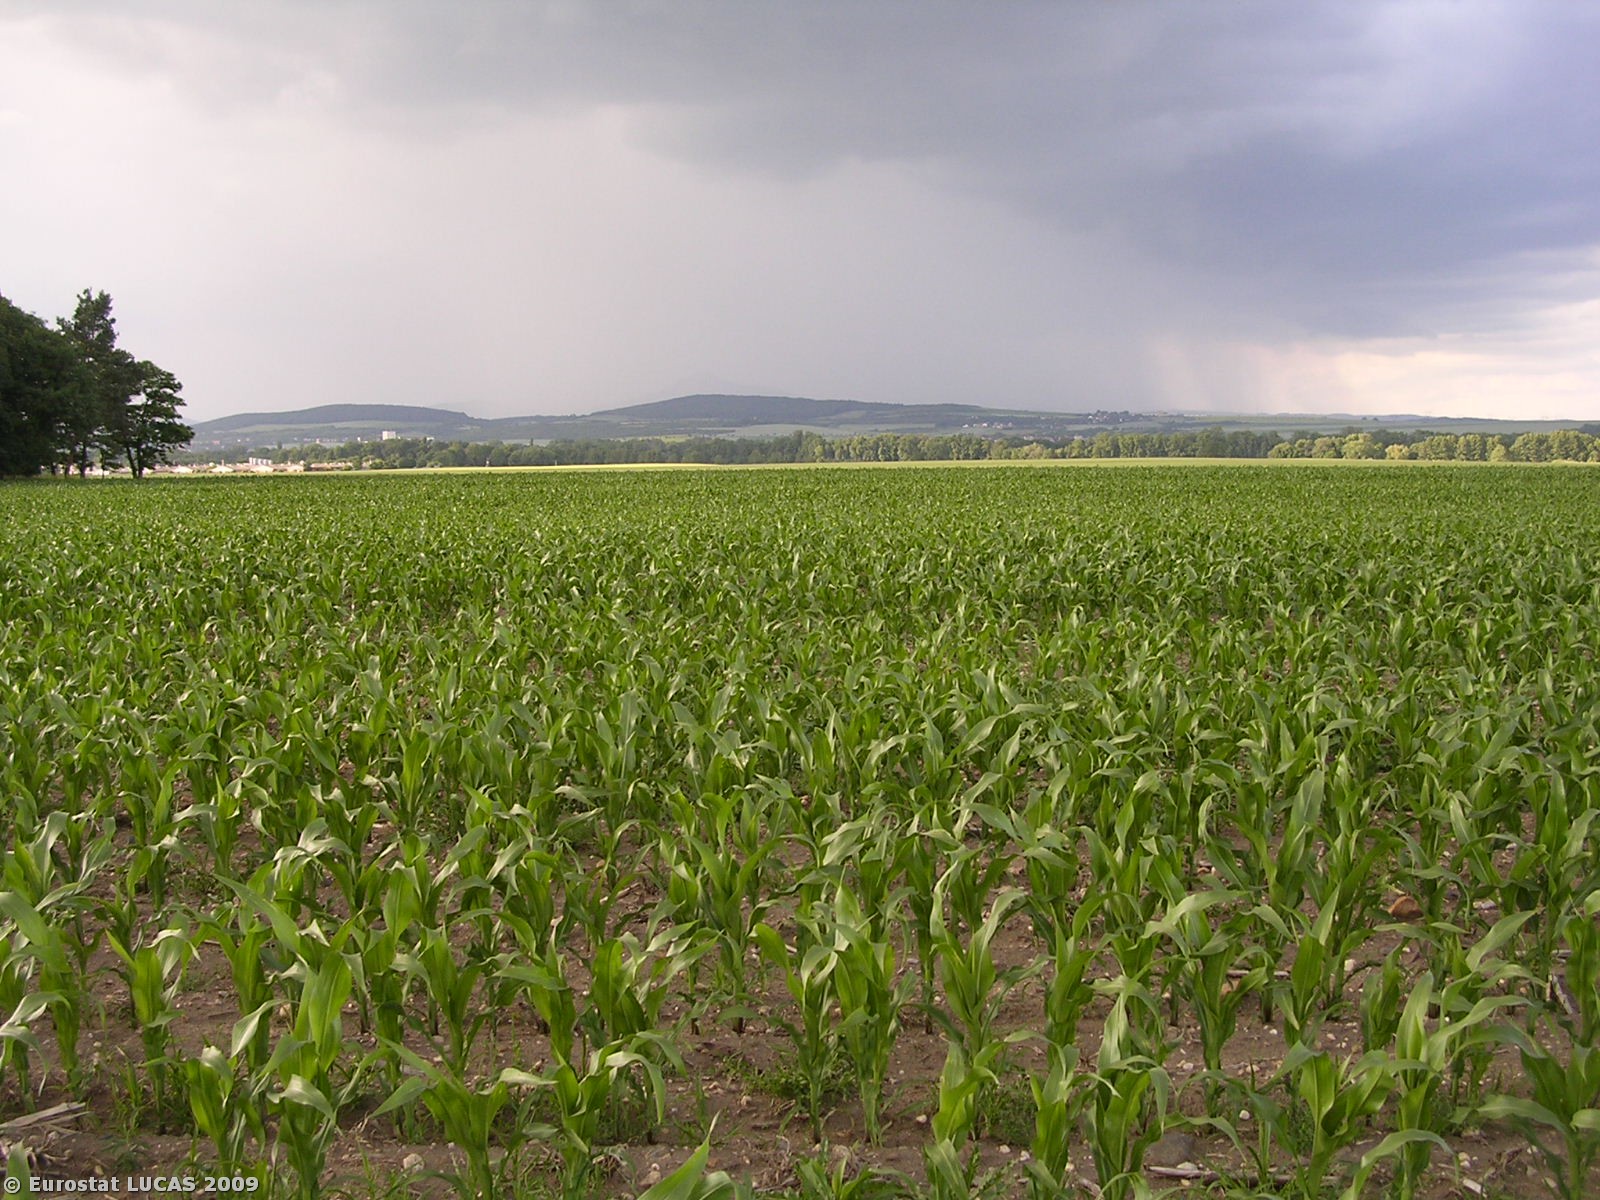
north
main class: Cropland
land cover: Maize
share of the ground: 25 - 50 %
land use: Agriculture (excluding fallow land and kitchen gardens)
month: June
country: CZ
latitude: 50.4824
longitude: 14.2716
